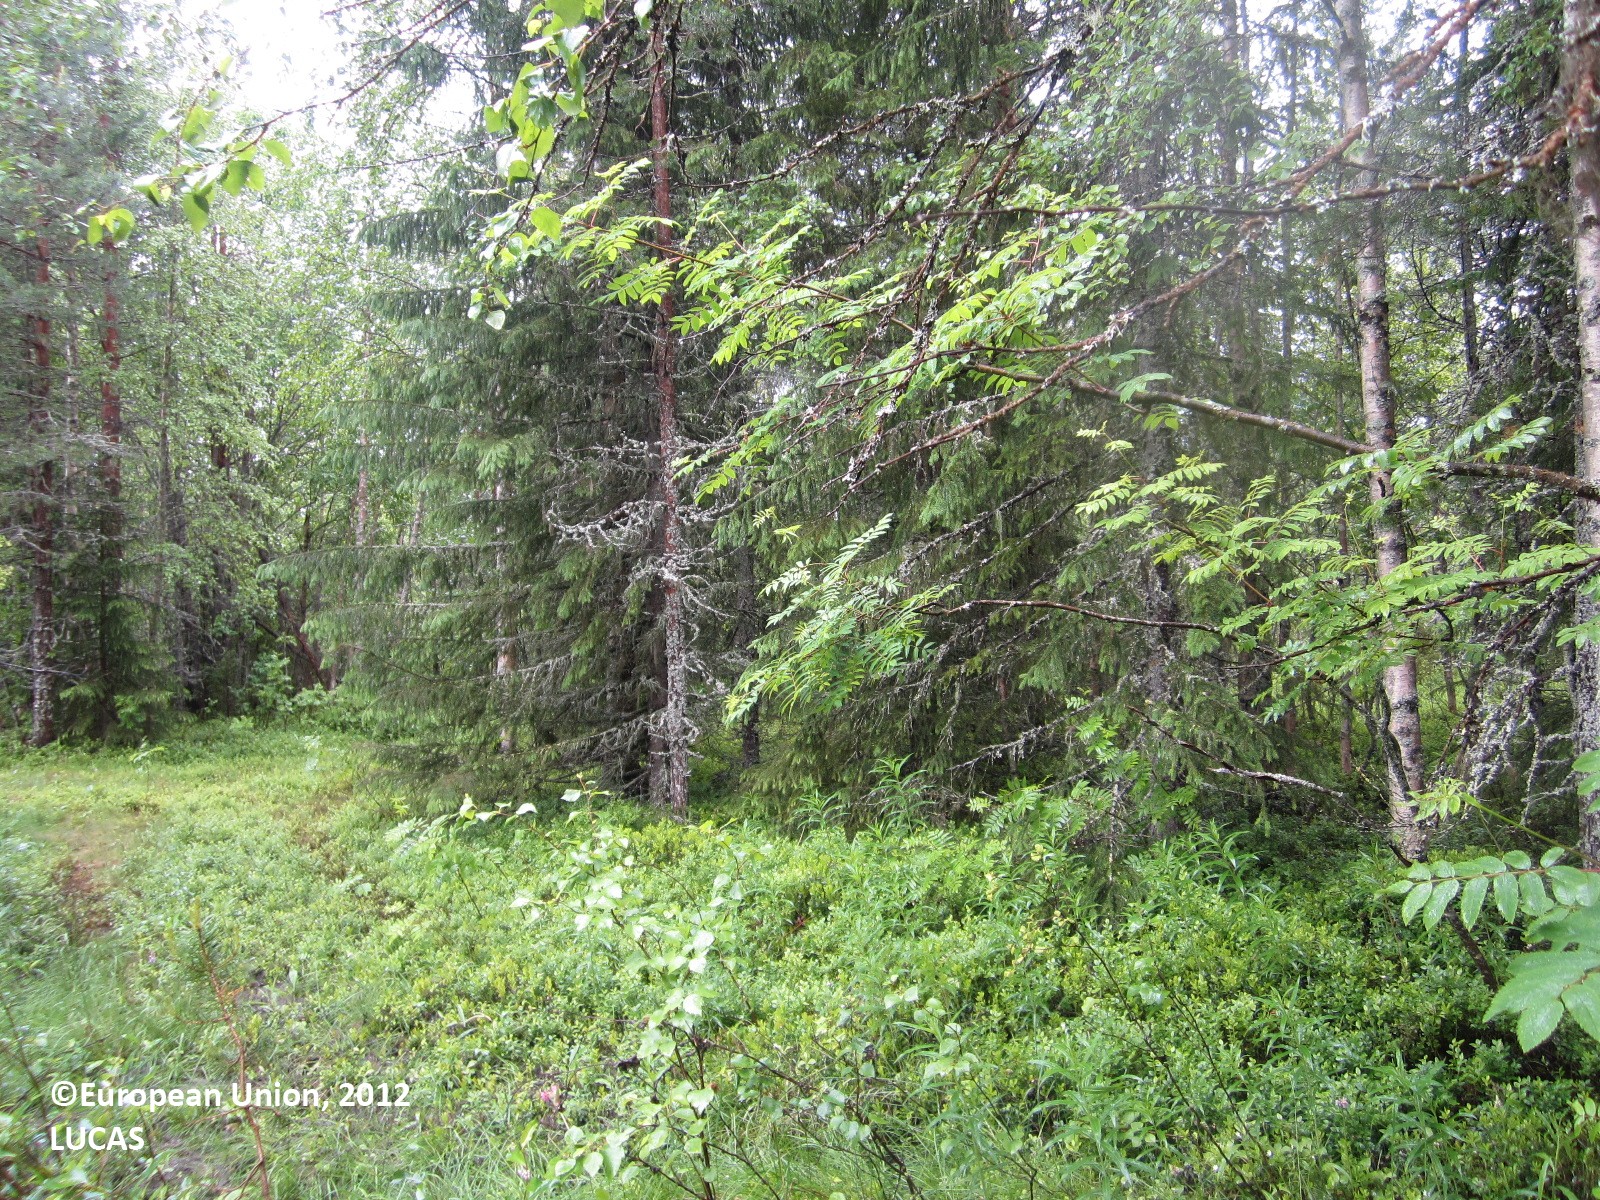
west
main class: Woodland
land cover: Spruce dominated mixed woodland
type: boreal forest
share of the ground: 50 - 75 %
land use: Forestry
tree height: > 5 m
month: June
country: FI
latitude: 64.6120
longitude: 29.9423
